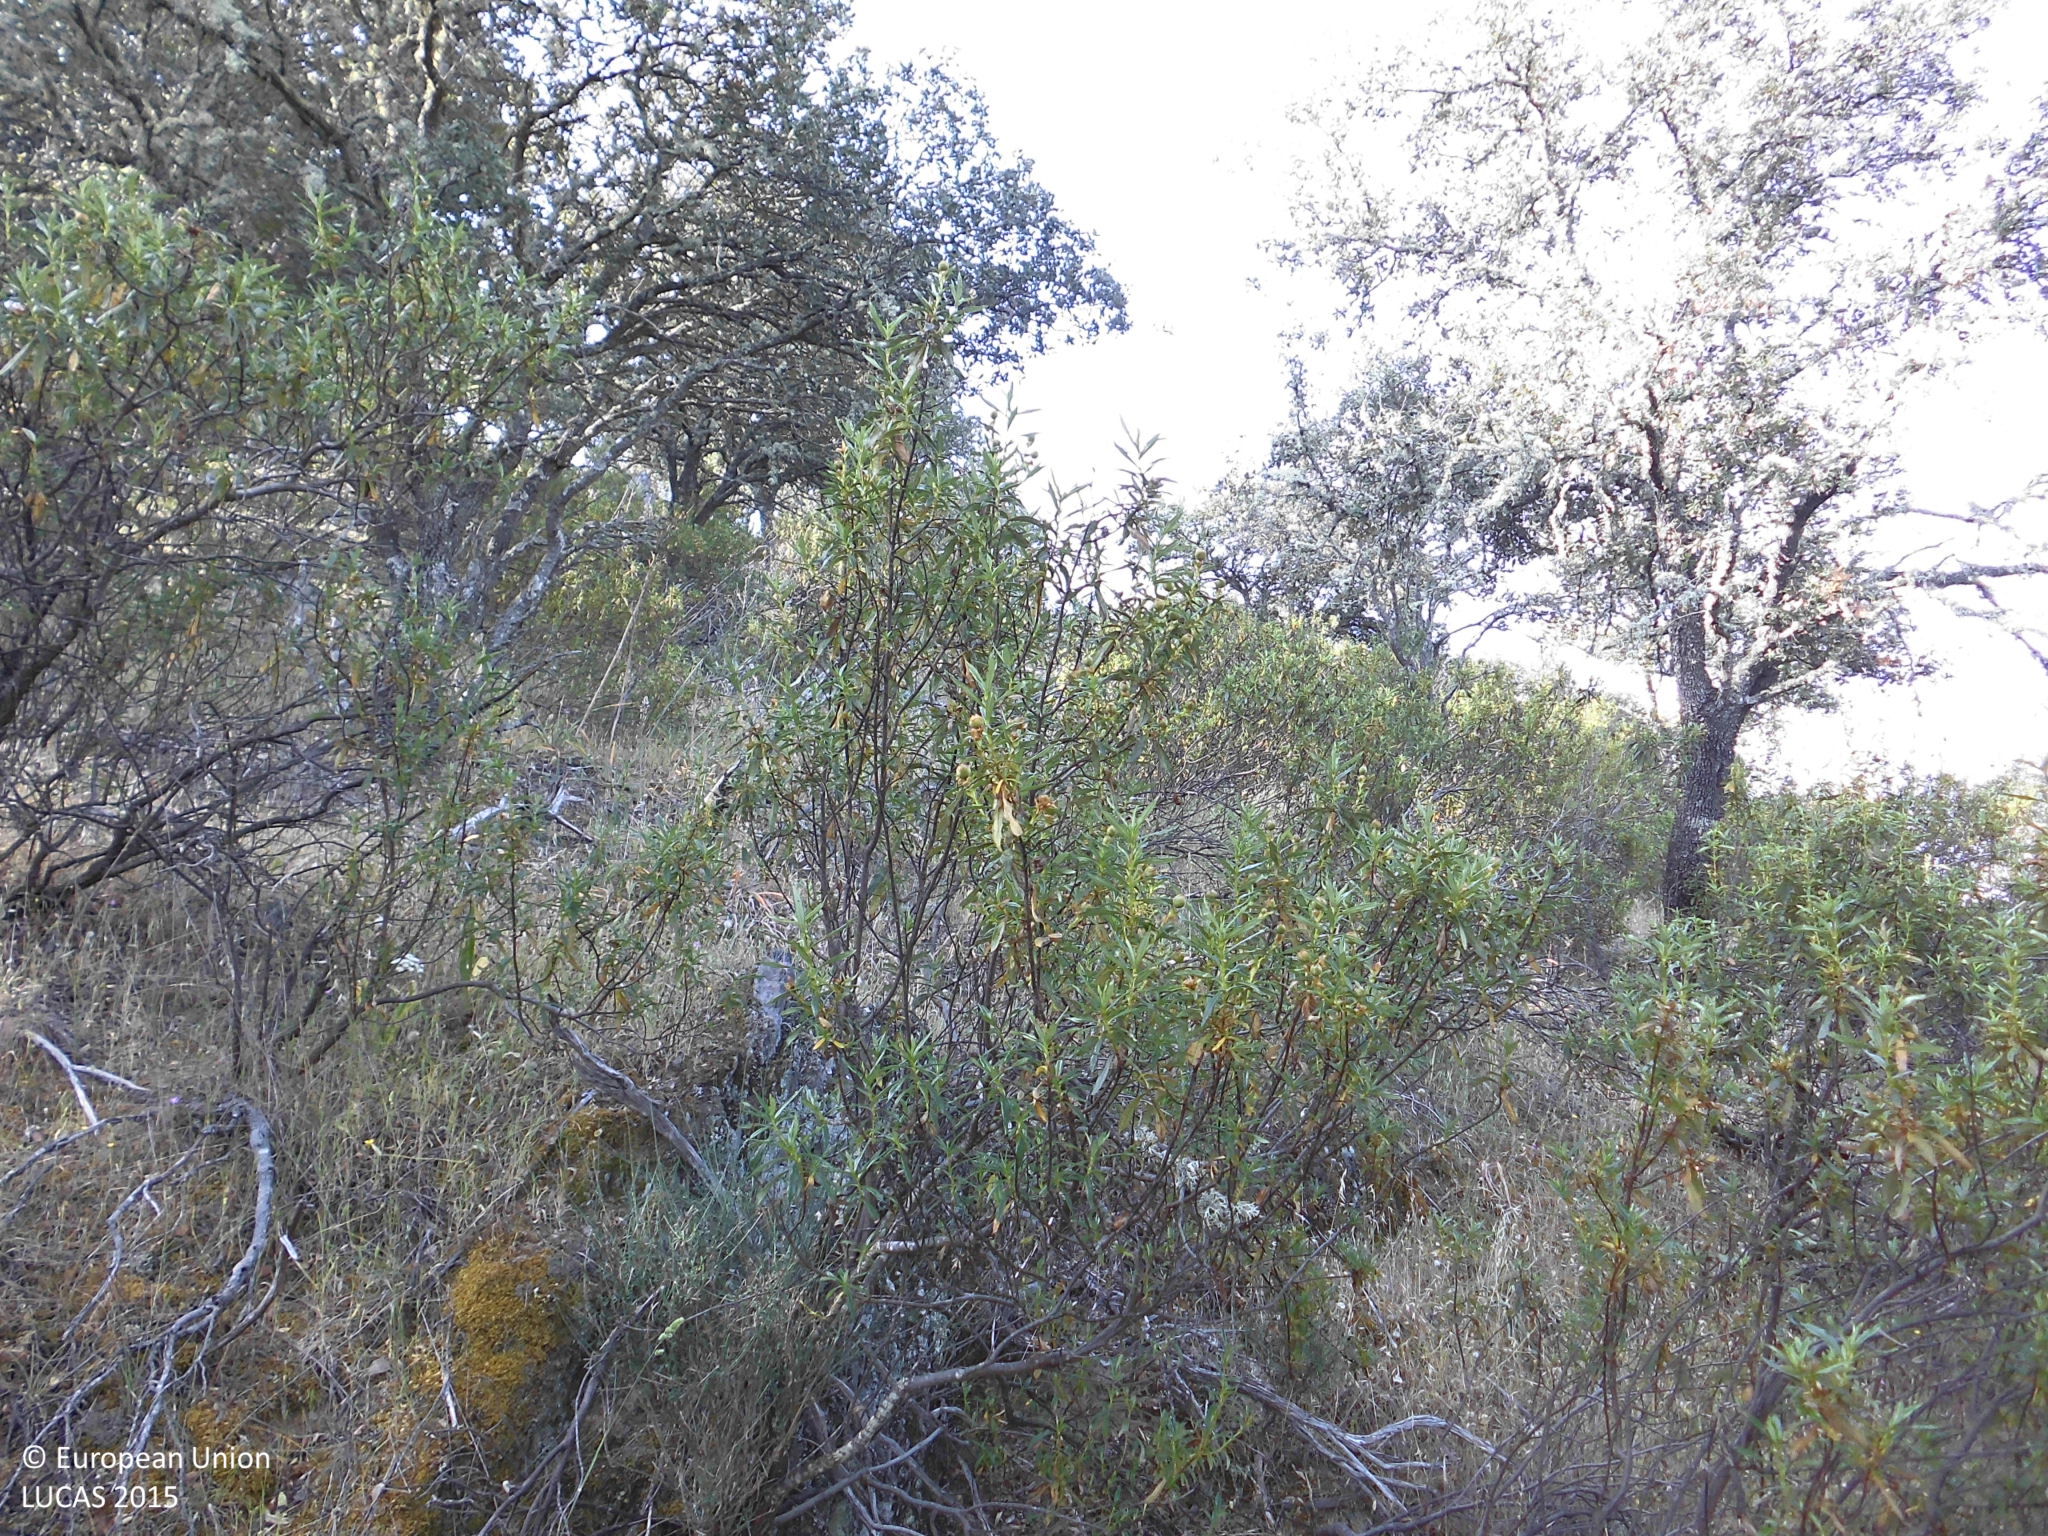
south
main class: Woodland
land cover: Broadleaved woodland
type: broadleaved evergreen forest
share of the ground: 50 - 75 %
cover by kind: broadleaved forest trees 50 %, shrubs 40 %, herbaceous plants 10 %
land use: Semi-natural and natural areas not in use
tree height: > 5 m
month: May
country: ES
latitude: 39.5652
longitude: -6.9955
